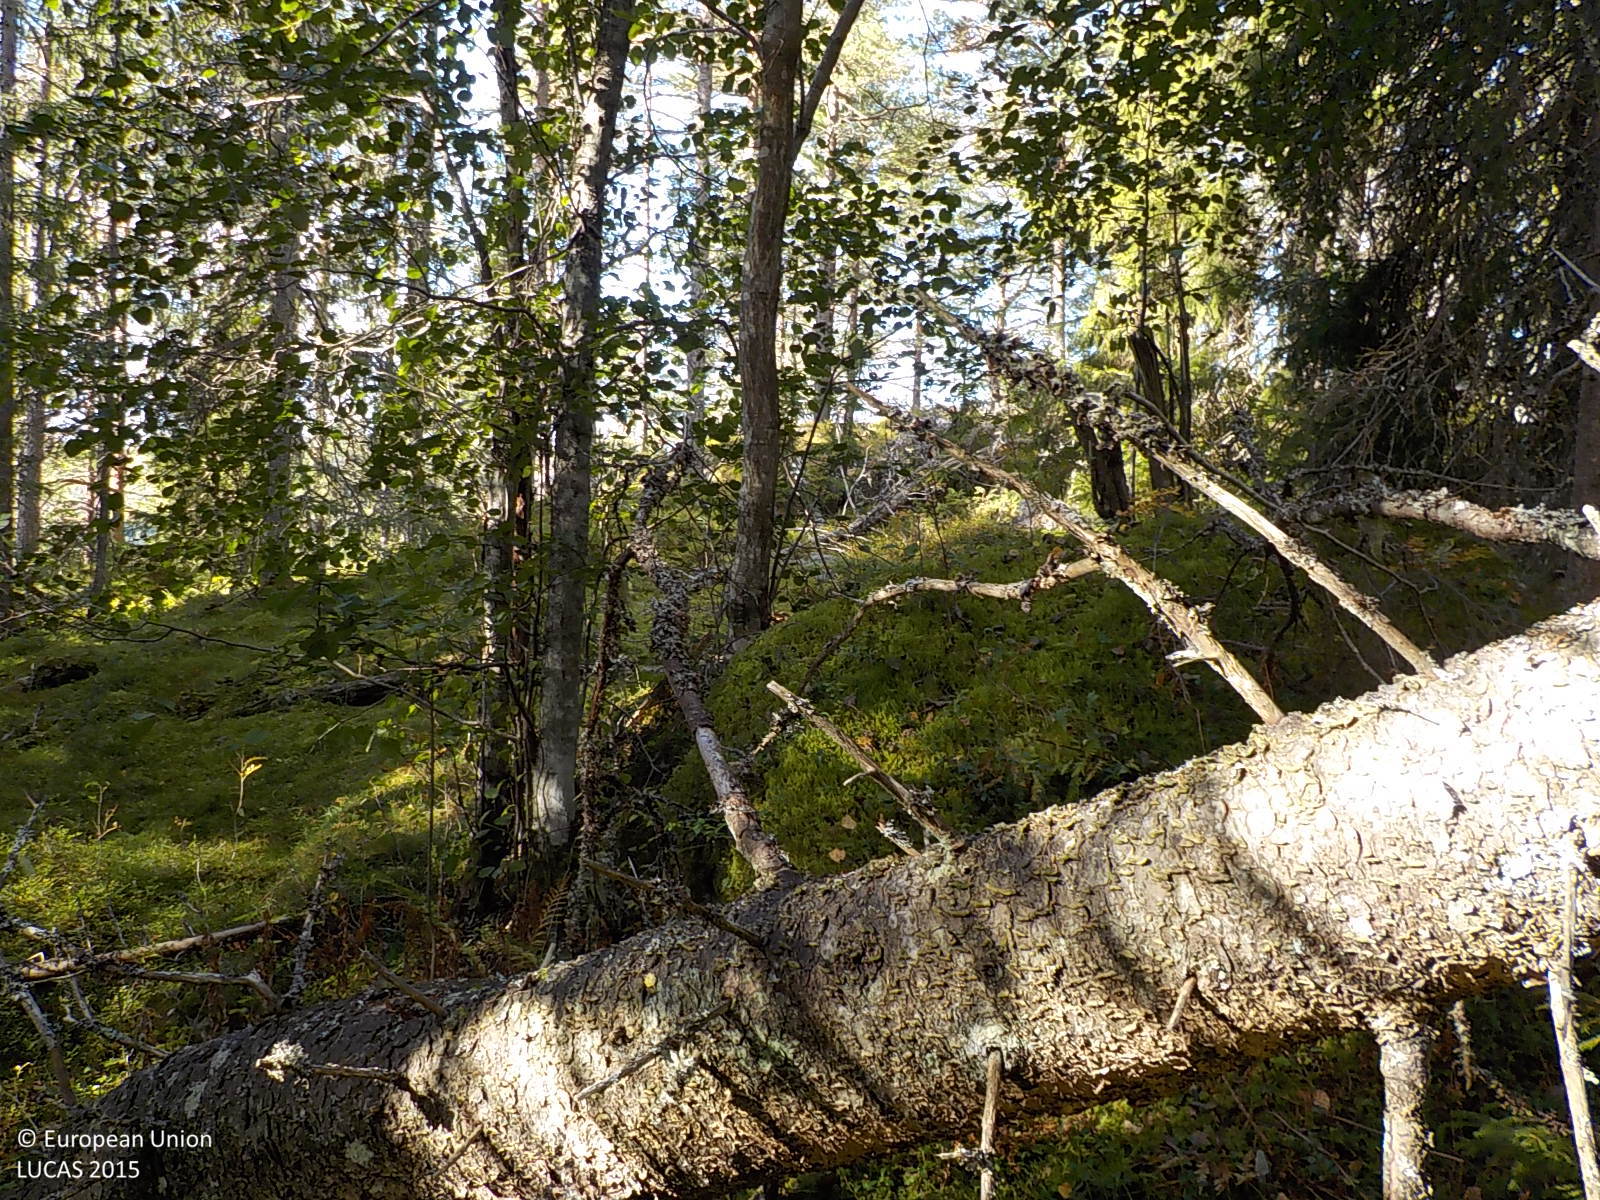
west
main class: Woodland
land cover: Spruce dominated coniferous woodland
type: boreal forest
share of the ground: > 75 %
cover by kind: coniferous forest trees 75 %, lichens and mosses 10 %, consolidated bare surface 10 %, shrubs 5 %
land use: Forestry
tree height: > 5 m
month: September
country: SE
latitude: 62.9184
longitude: 18.4659
